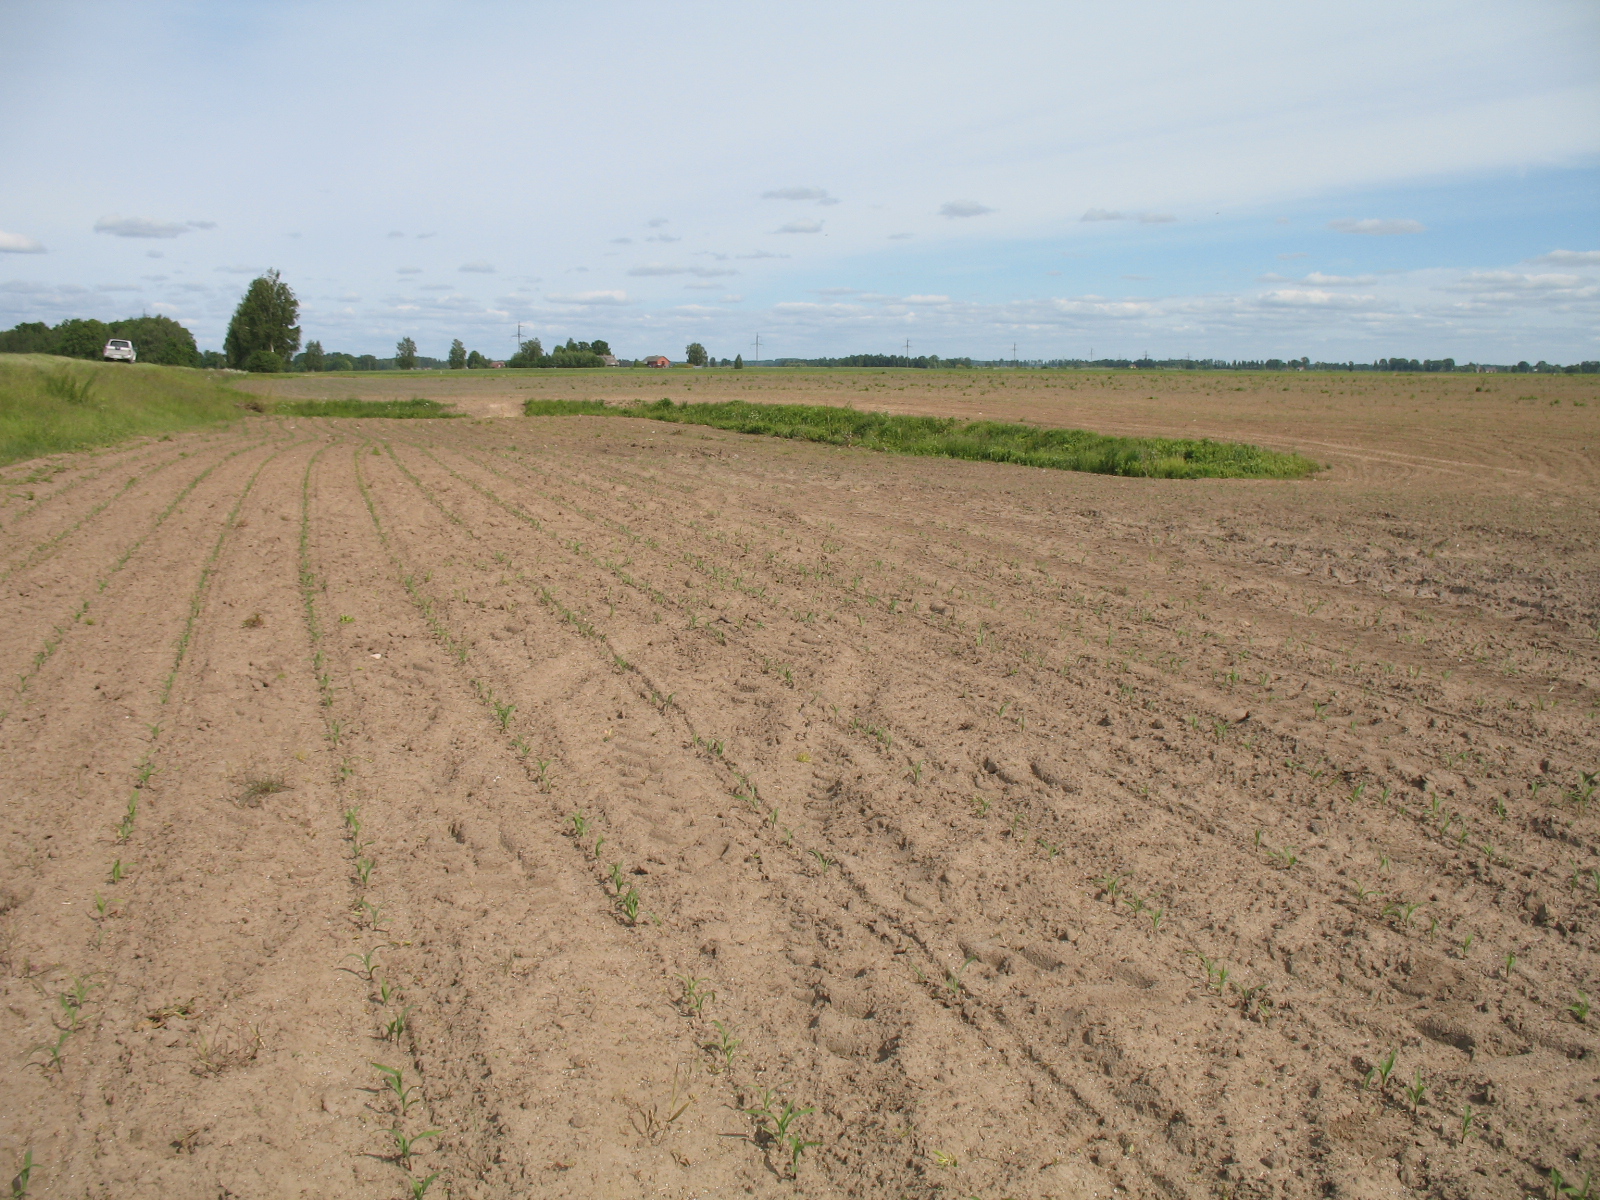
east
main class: Cropland
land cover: Maize
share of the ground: < 10 %
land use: Agriculture (excluding fallow land and kitchen gardens)
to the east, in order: Maize; Grass margins; Ditches and canals; Grass margins; Maize
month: June
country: LV
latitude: 56.6218
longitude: 23.4873
